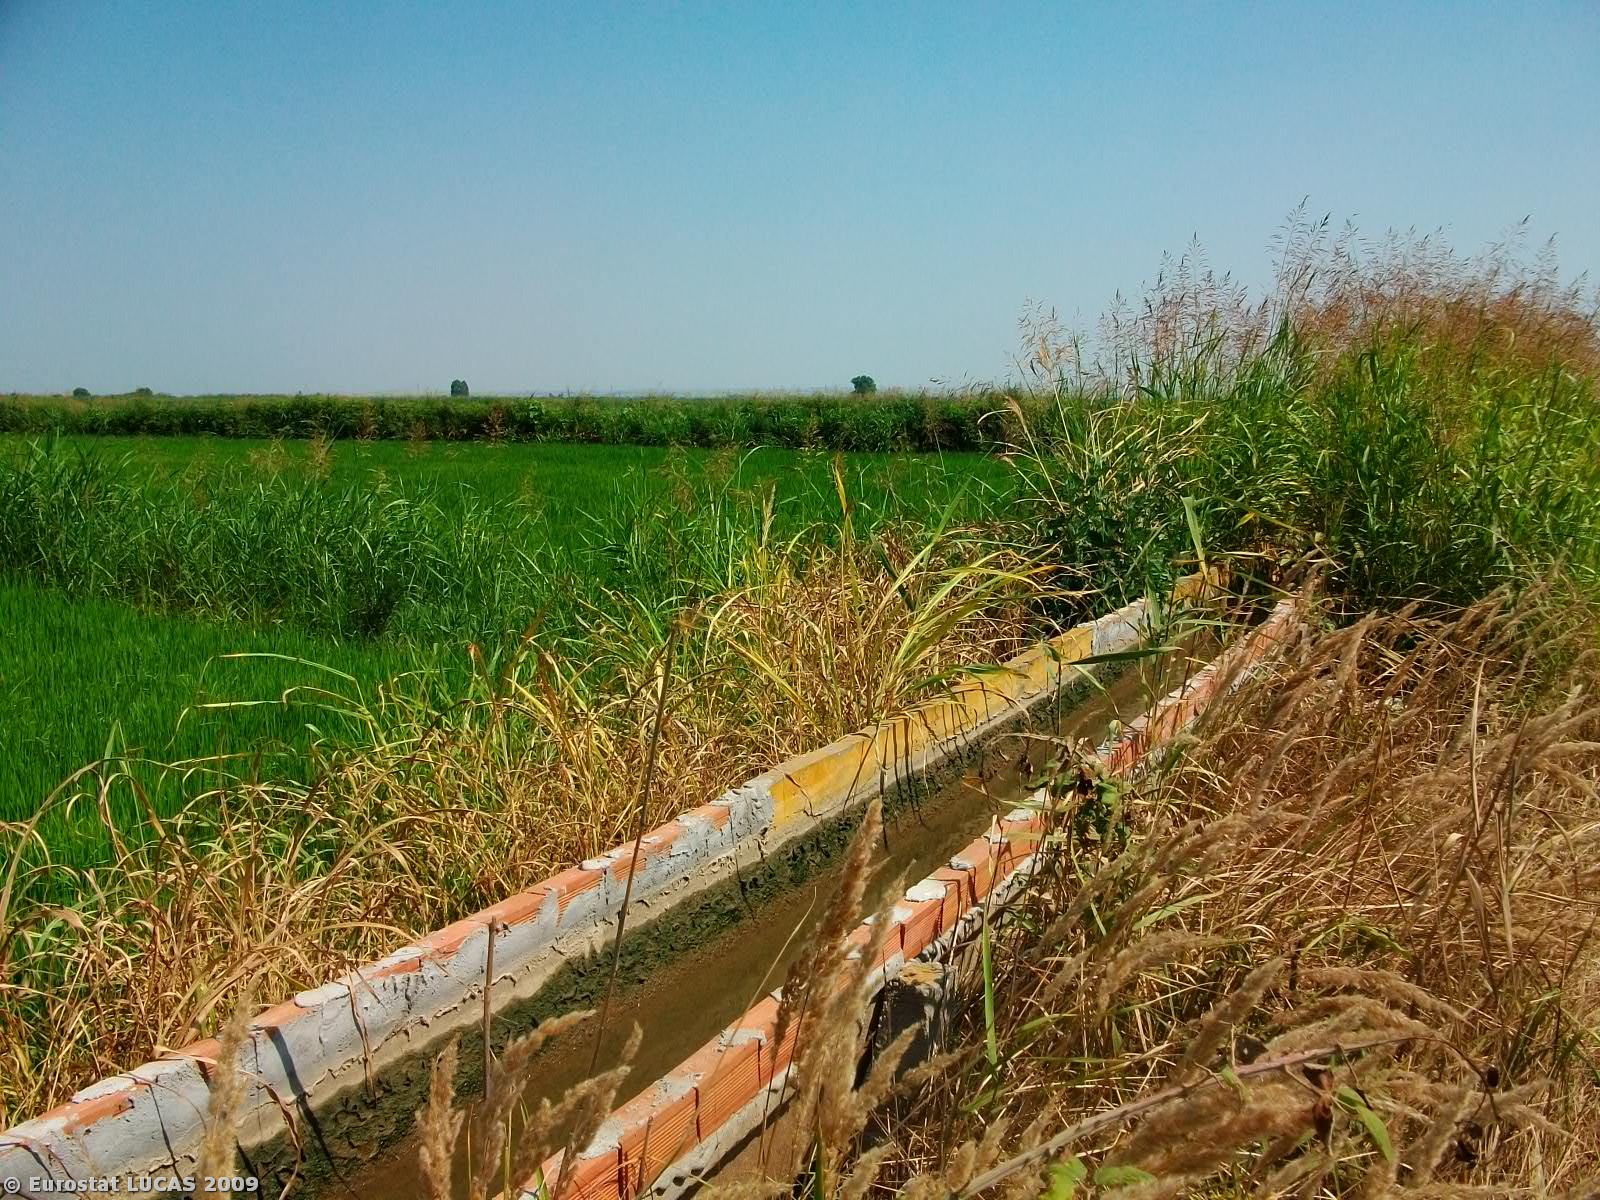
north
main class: Cropland
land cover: Rice
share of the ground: > 75 %
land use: Agriculture (excluding fallow land and kitchen gardens)
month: July
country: GR
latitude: 40.6492
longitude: 22.6699
